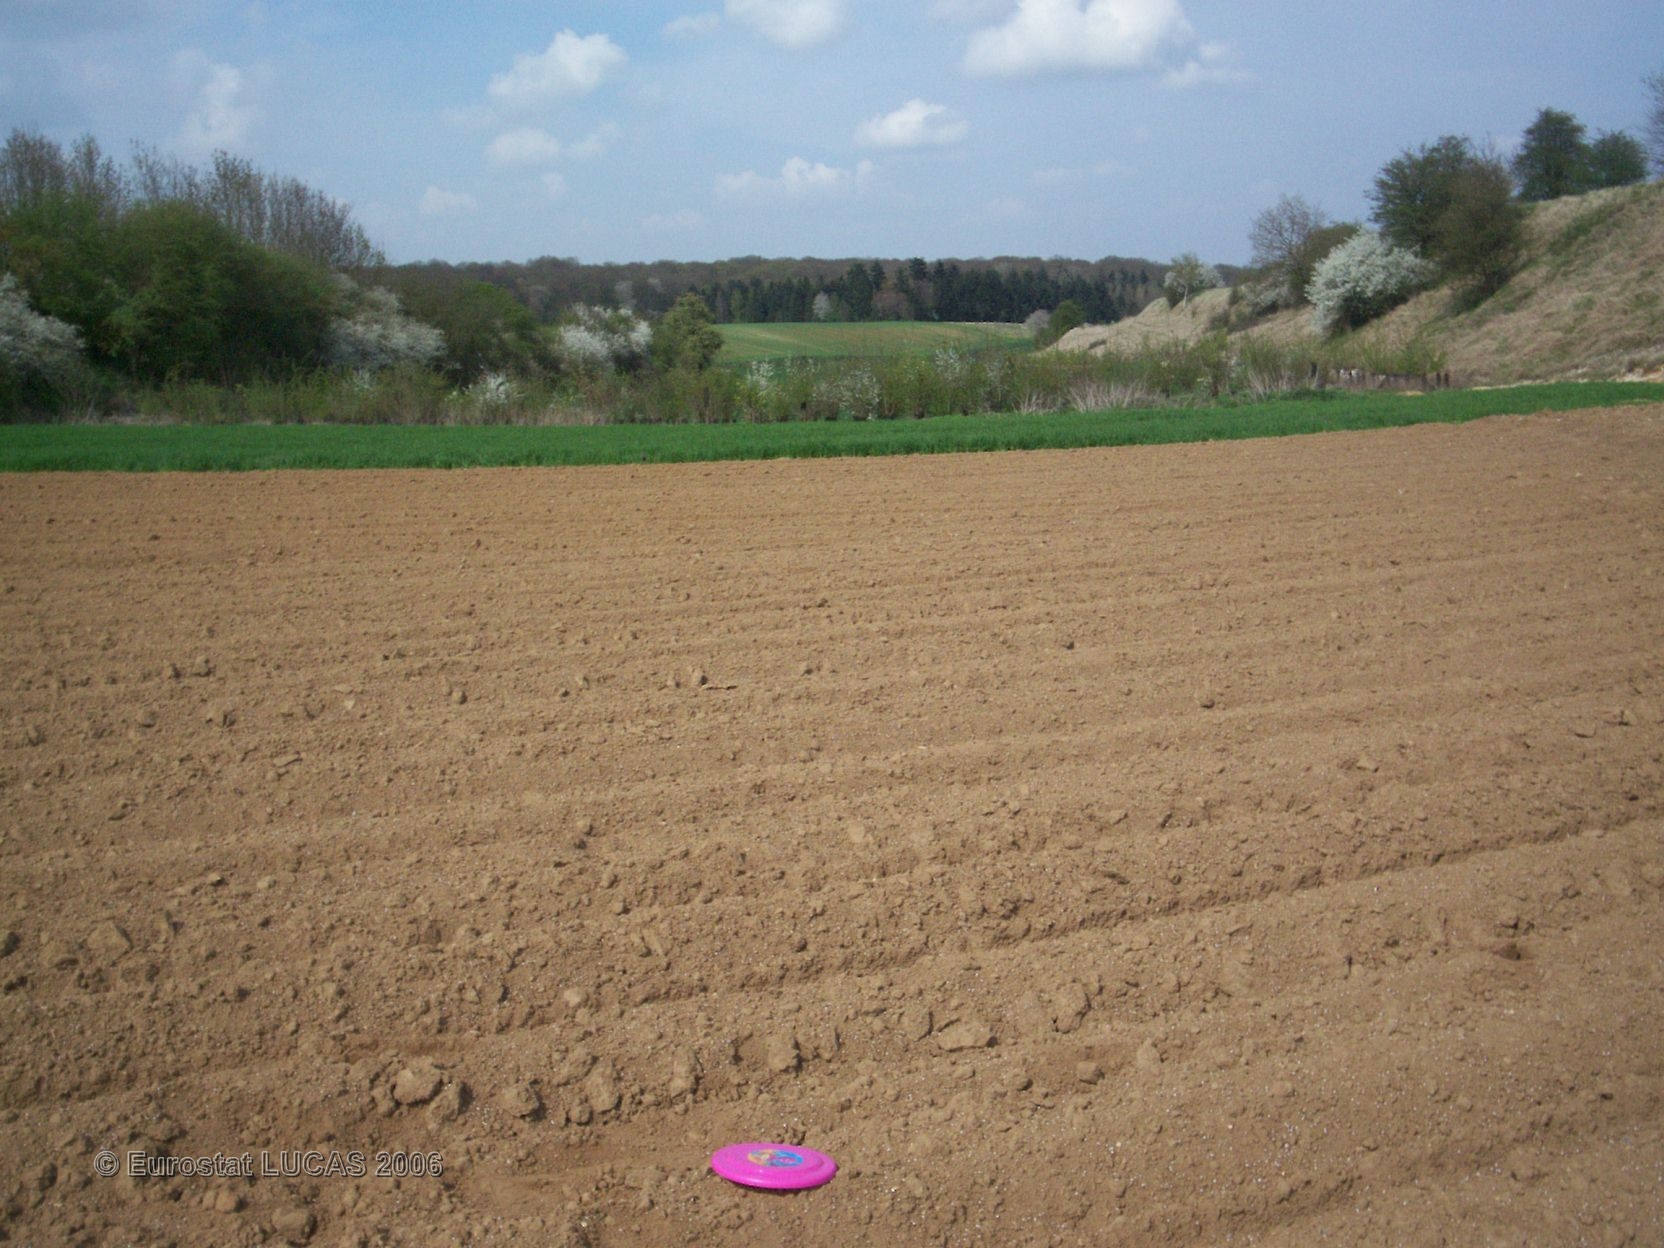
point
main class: Cropland
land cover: Potatoes
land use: Agriculture (excluding fallow land and kitchen gardens)
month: April
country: FR
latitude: 49.9429
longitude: 2.5889
